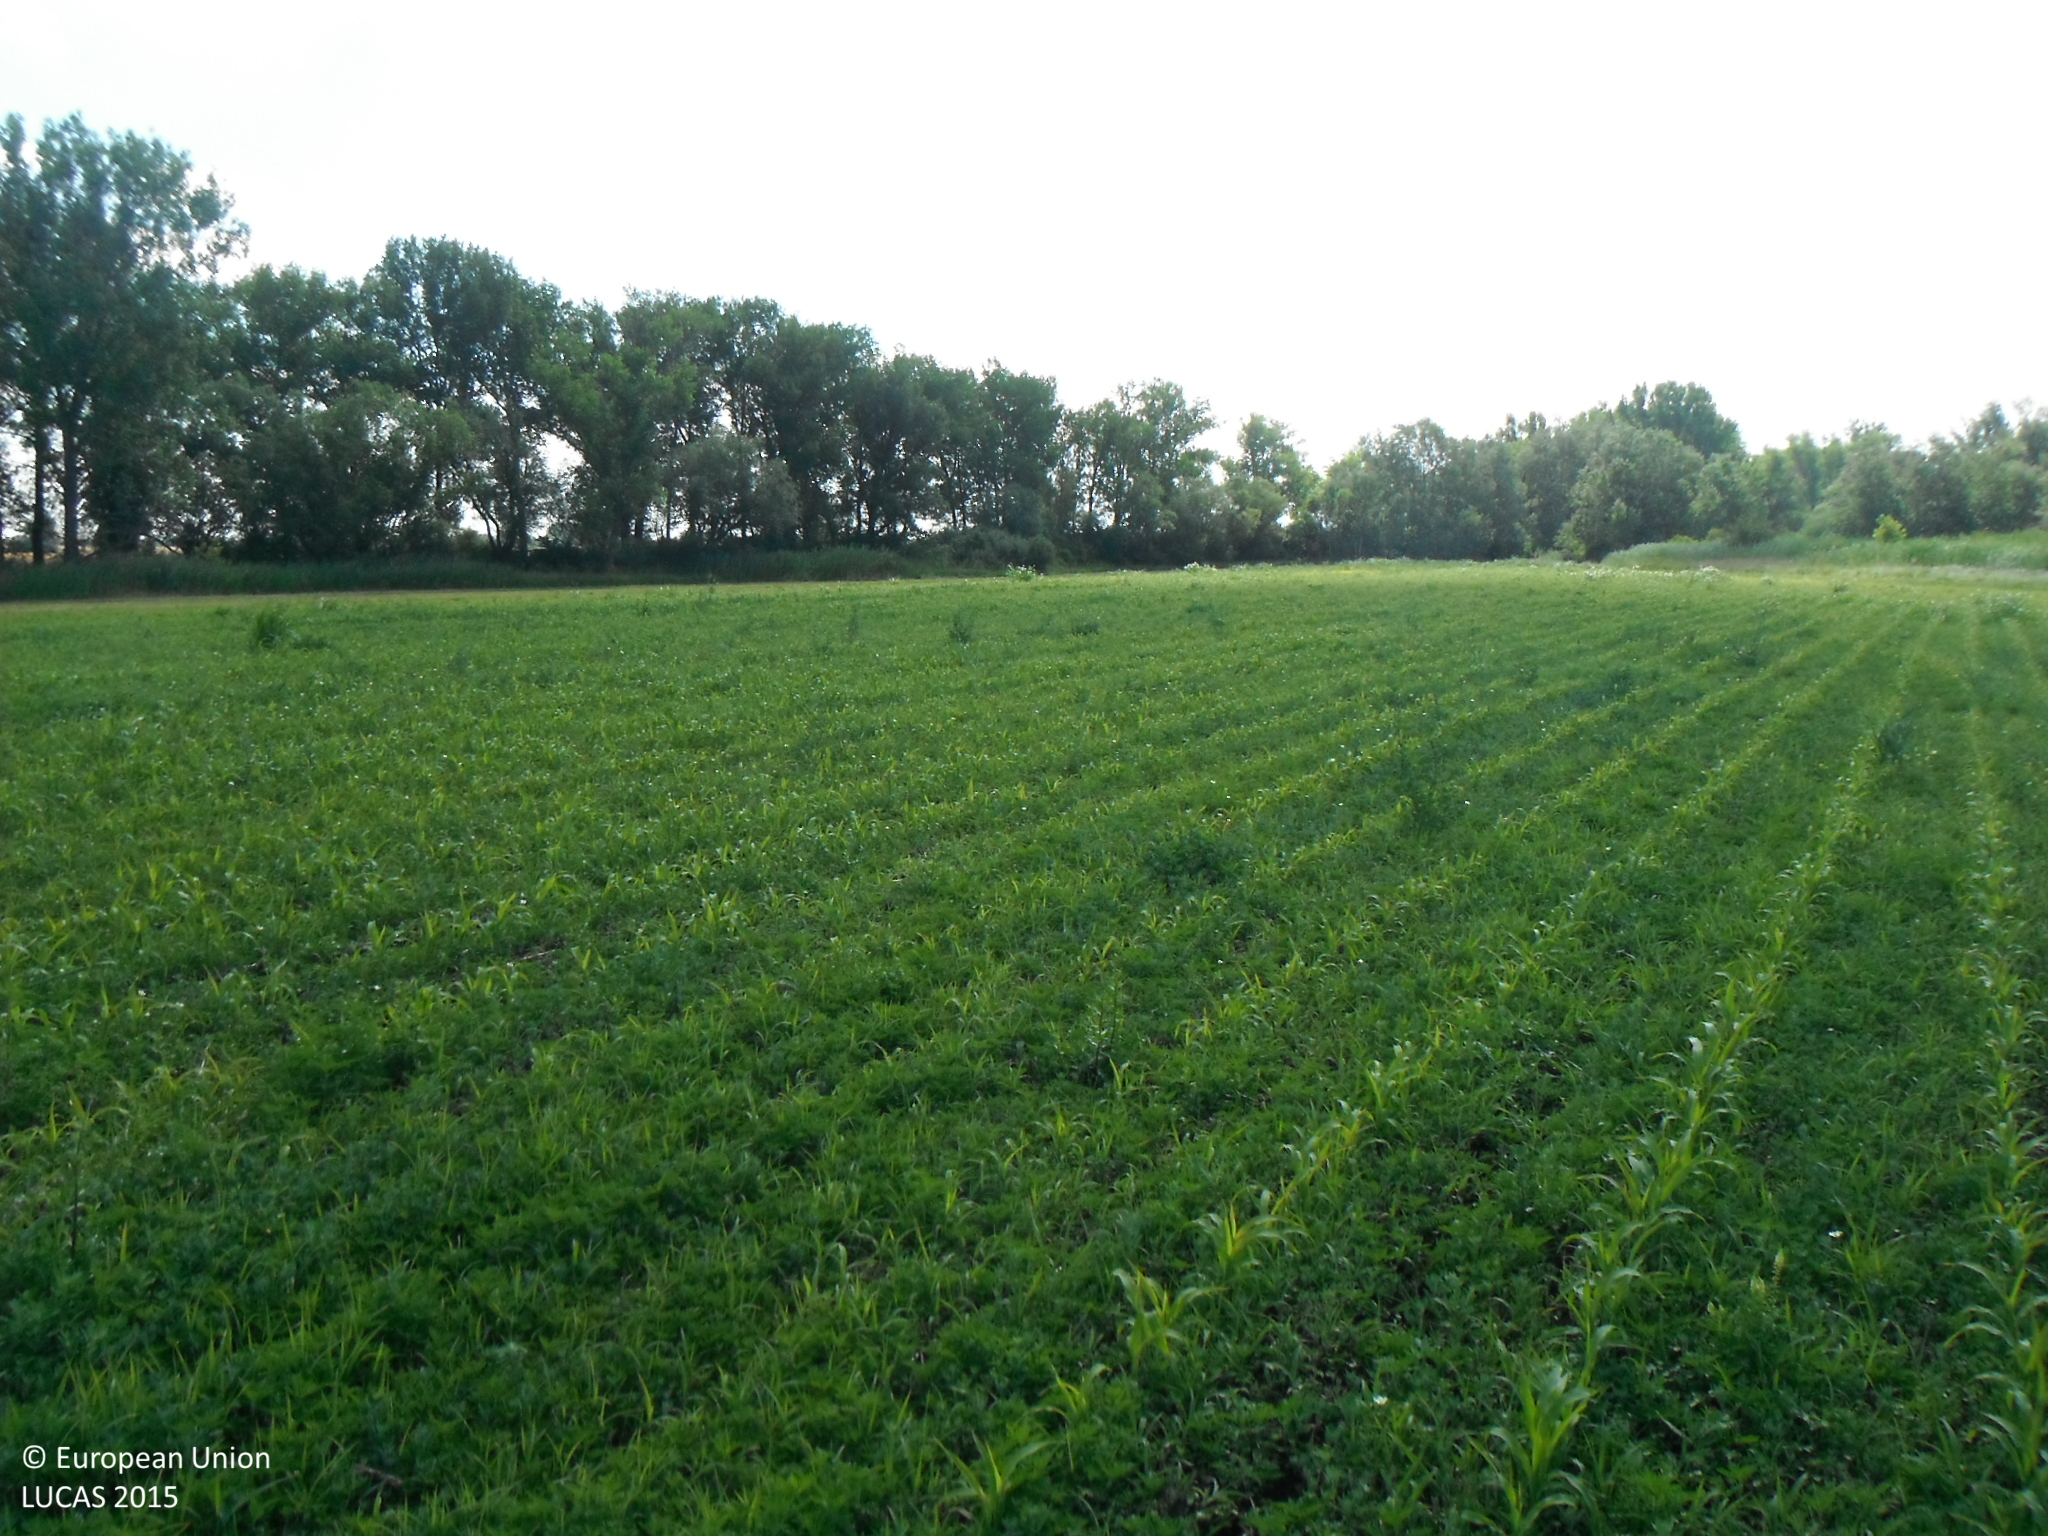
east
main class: Cropland
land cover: Maize
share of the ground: 10 - 25 %
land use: Agriculture (excluding fallow land and kitchen gardens)
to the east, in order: Maize; Grassland without tree/shrub cover; Inland marshes; Broadleaved woodland; Ditches and canals; Broadleaved woodland; Grassland with sparse tree/shrub cover; Common wheat
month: June
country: SK
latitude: 47.7557
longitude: 18.1901
